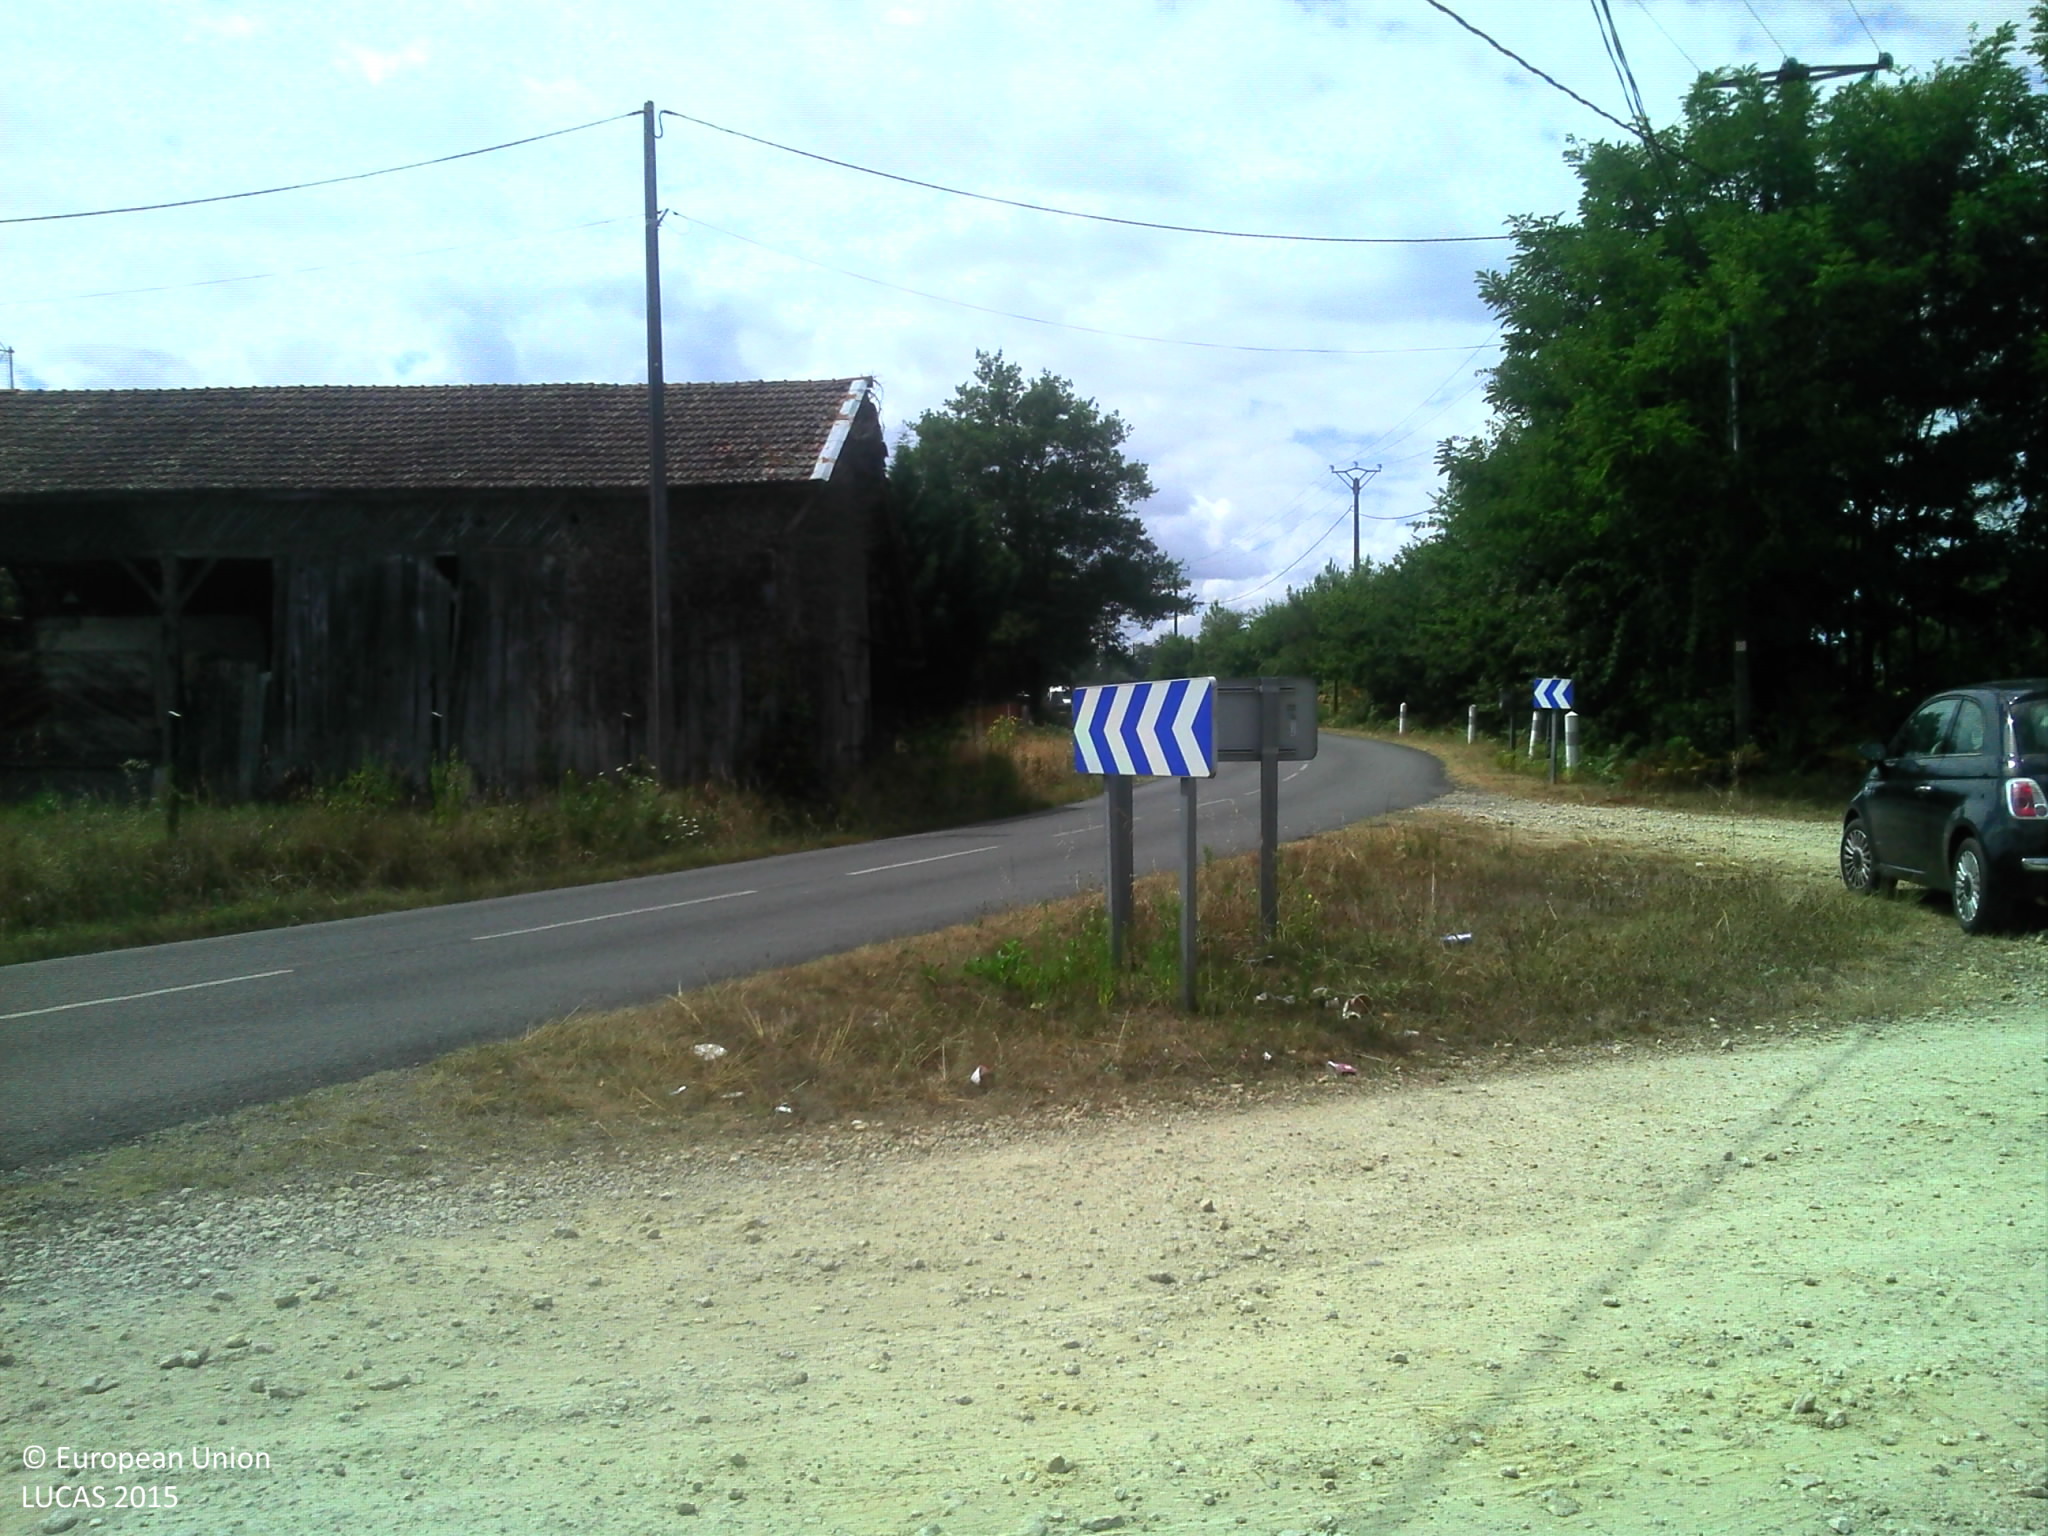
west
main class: Woodland
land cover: Broadleaved woodland
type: thermophilous deciduous forest
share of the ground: > 75 %
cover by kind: broadleaved forest trees 80 %, herbaceous plants 20 %
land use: Forestry
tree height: > 5 m
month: July
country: FR
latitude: 43.9674
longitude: -0.7965
